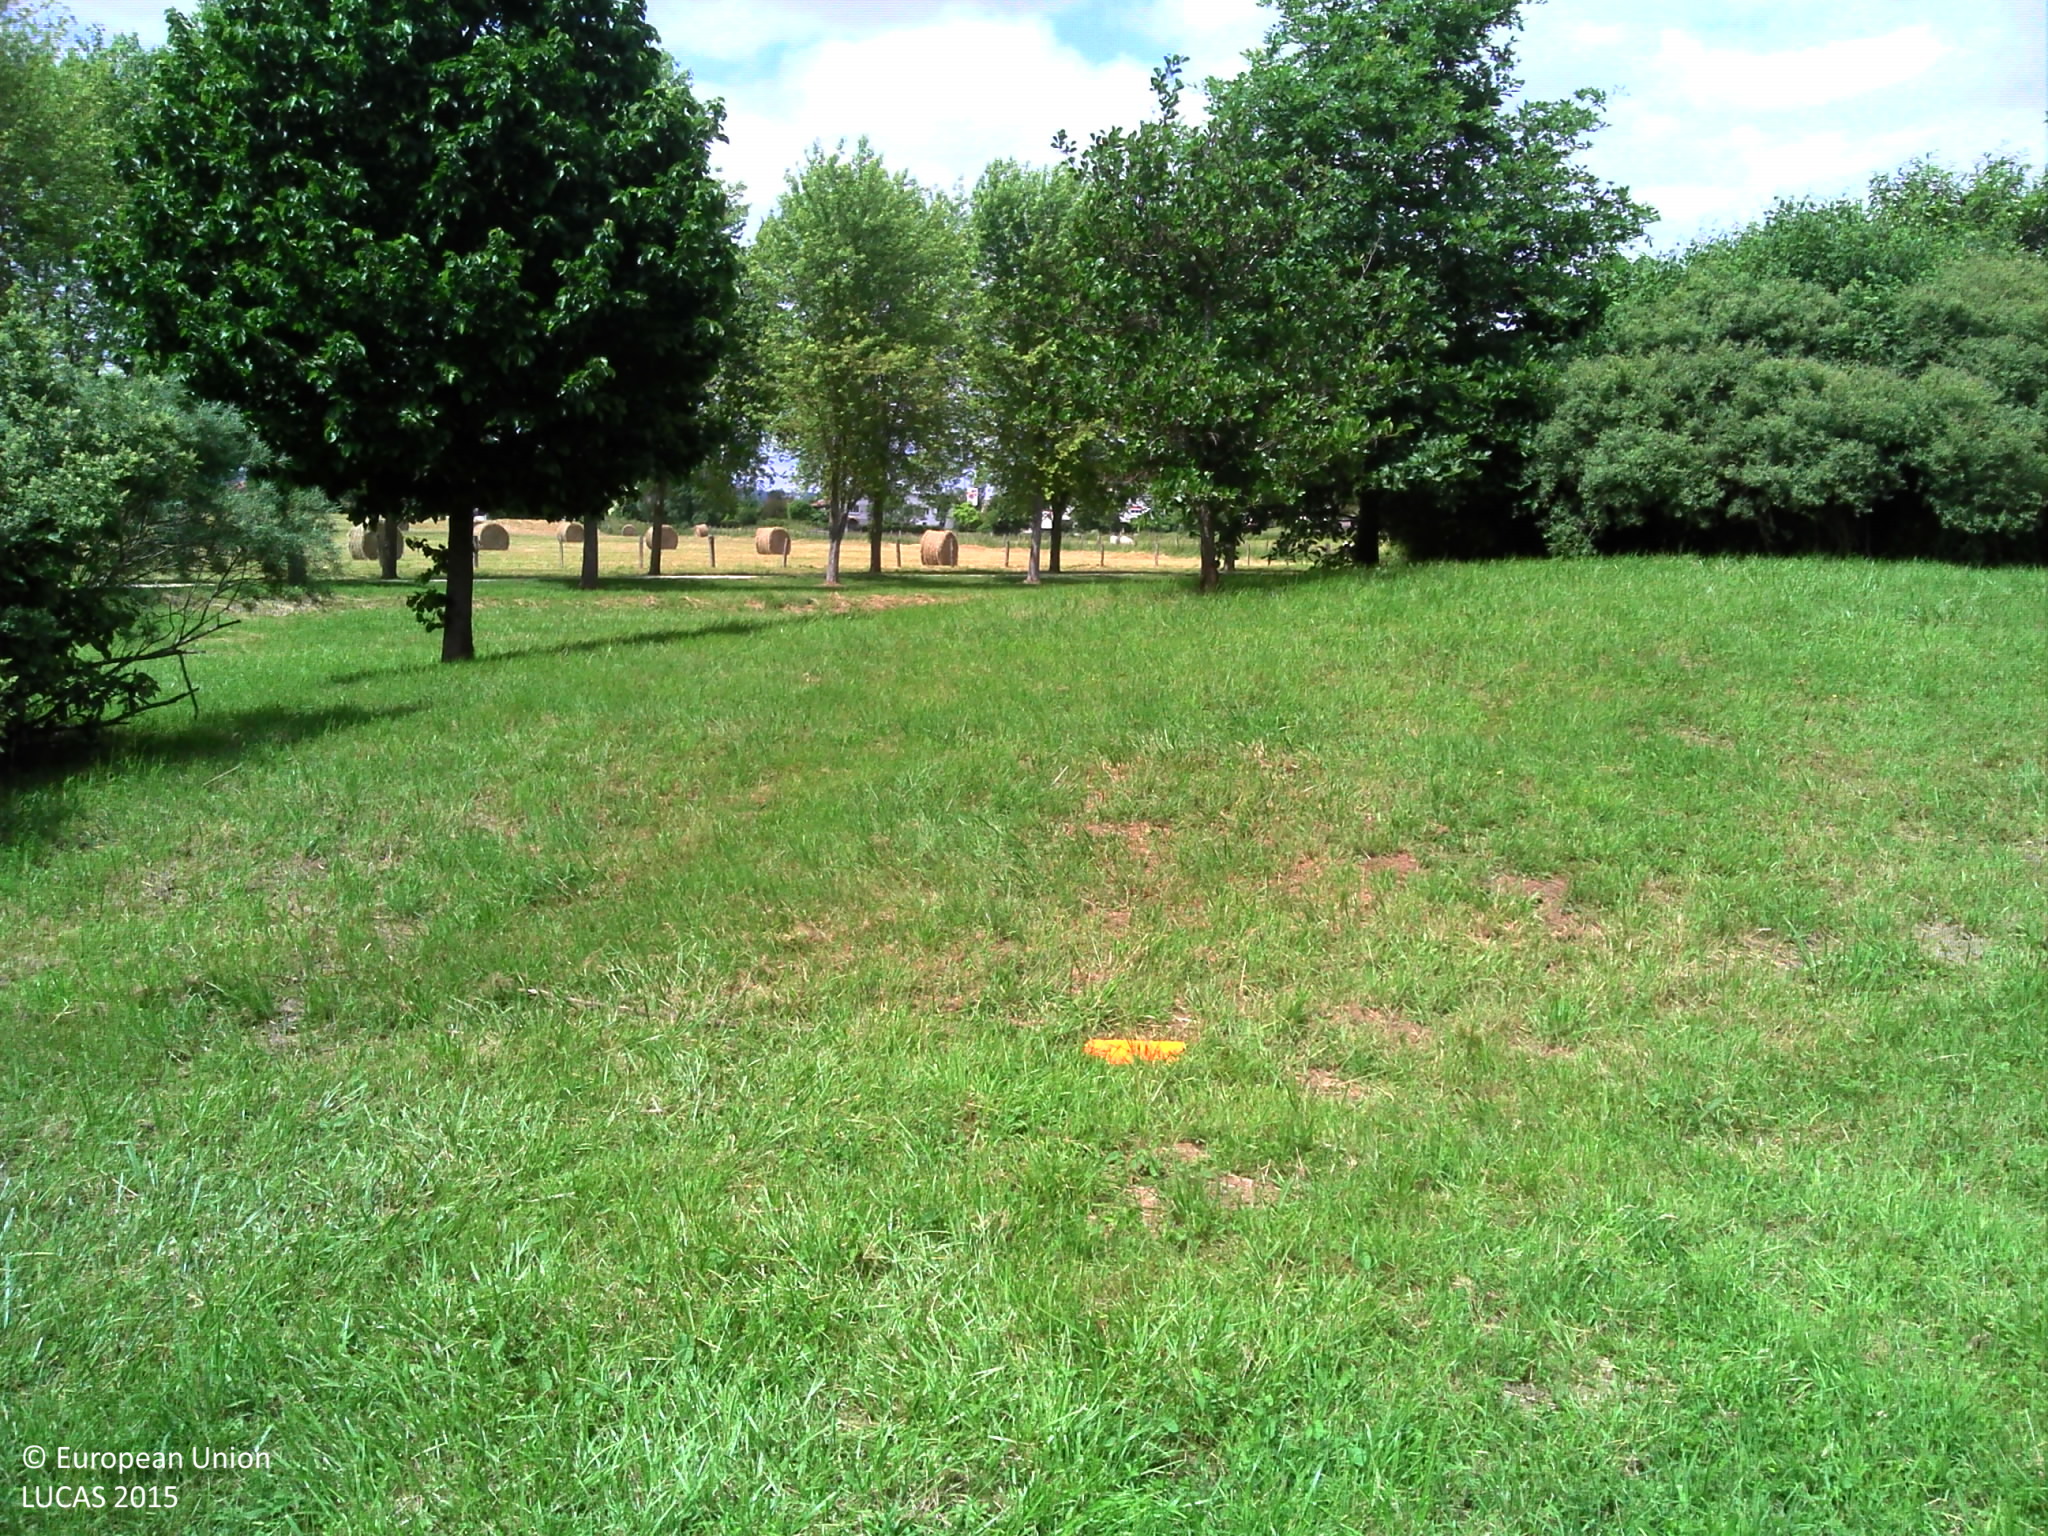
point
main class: Grassland
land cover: Grassland with sparse tree/shrub cover
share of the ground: > 75 %
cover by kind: herbaceous plants 95 %, broadleaved forest trees 5 %
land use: Amenities, museums, leisure
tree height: < 5 m
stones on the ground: < 10 %
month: June
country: FR
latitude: 48.6817
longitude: 6.2378
